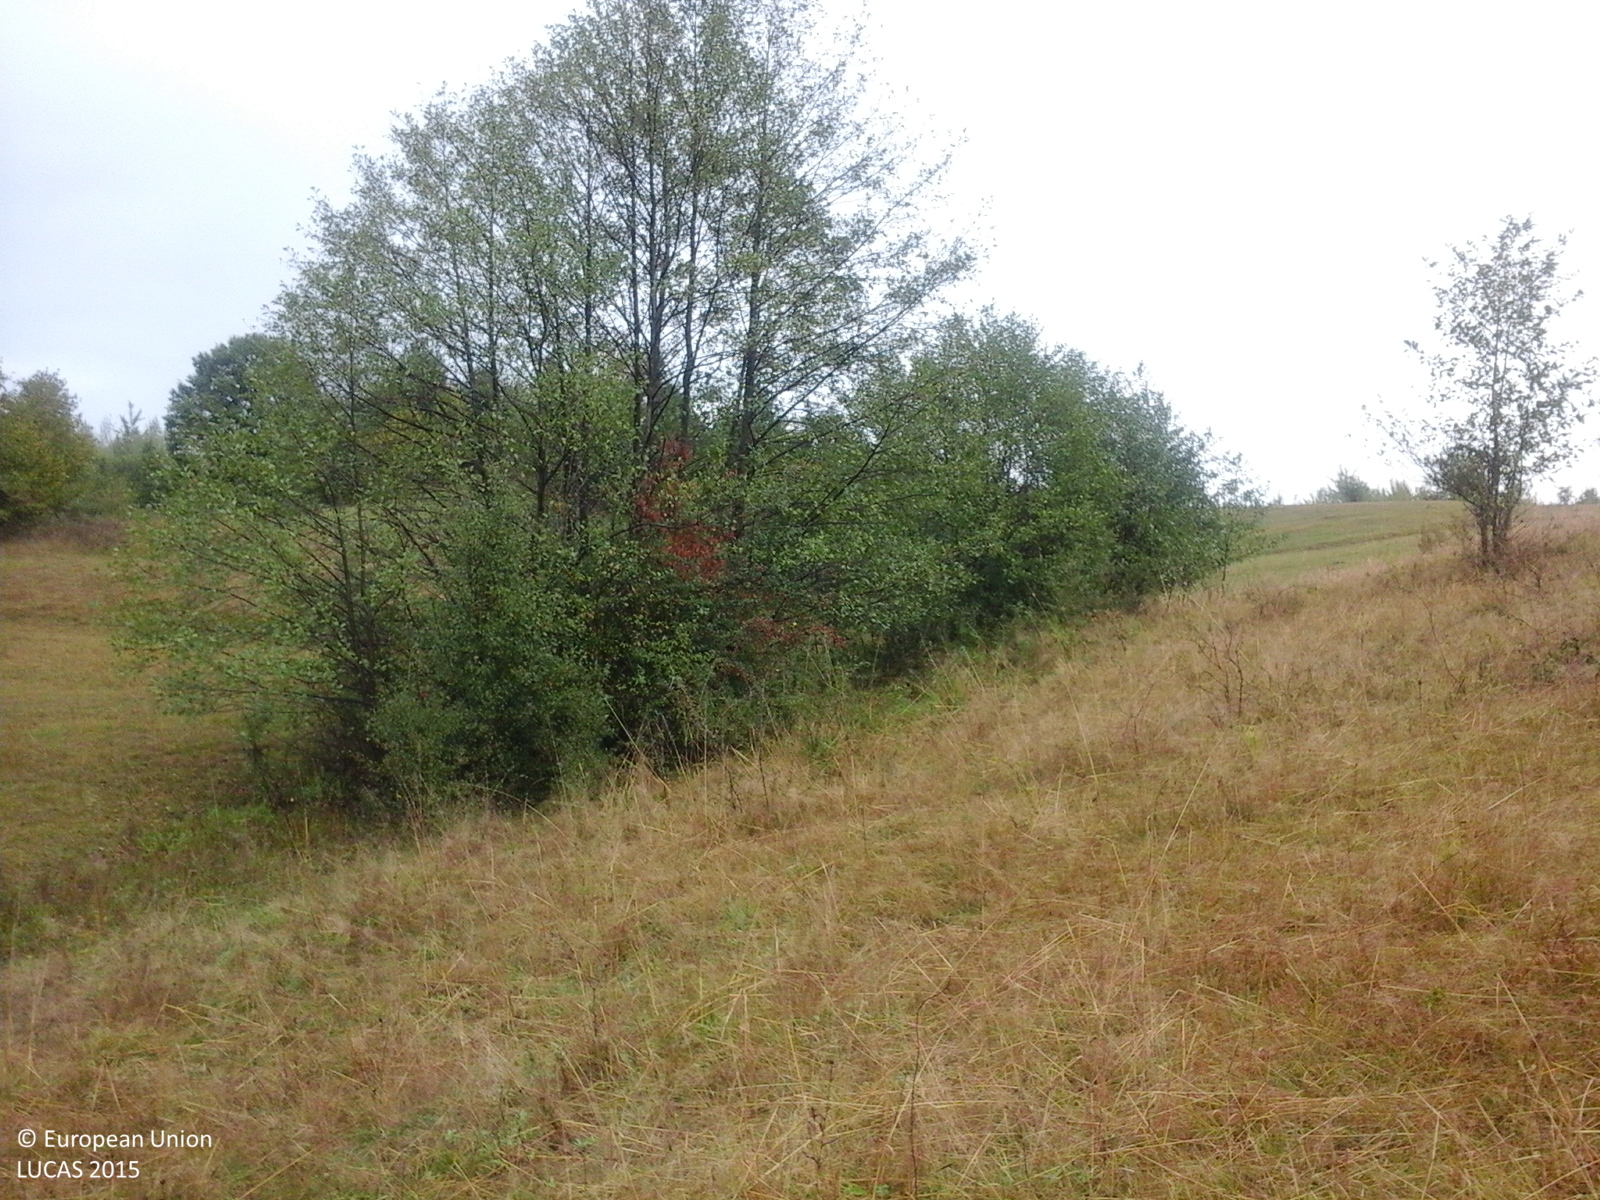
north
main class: Grassland
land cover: Grassland without tree/shrub cover
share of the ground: > 75 %
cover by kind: herbaceous plants 100 %
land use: Agriculture (excluding fallow land and kitchen gardens)
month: September
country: RO
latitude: 45.1516
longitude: 23.5806
